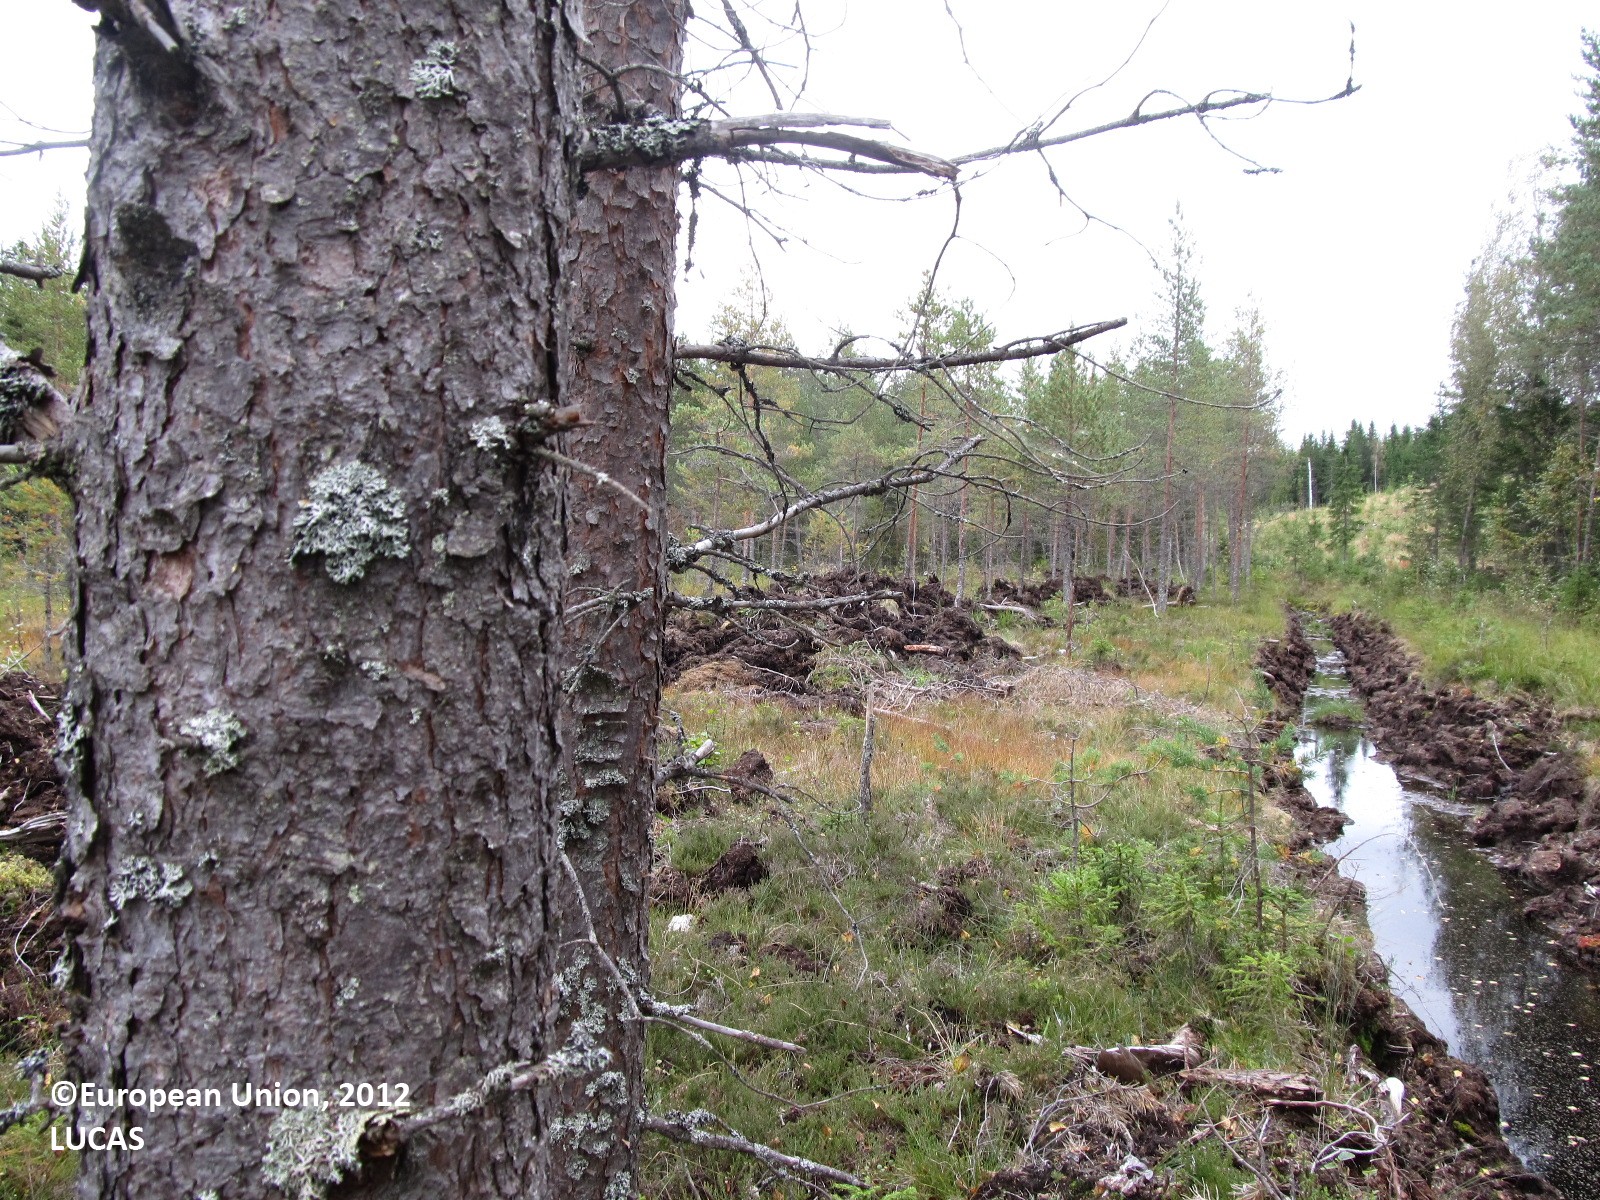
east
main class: Woodland
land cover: Pine dominated coniferous woodland
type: boreal forest
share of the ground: 25 - 50 %
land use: Forestry
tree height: > 5 m
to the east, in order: Pine dominated coniferous woodland; Ditches and canals; Pine dominated coniferous woodland; Ditches and canals; Spruce dominated coniferous woodland; Ditches and canals; Spruce dominated coniferous woodland; Ditches and canals; Spruce dominated coniferous woodland; Paved roads, cycling and walking lanes; Spruce dominated coniferous woodland
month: September
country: FI
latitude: 63.0653
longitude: 28.5394
